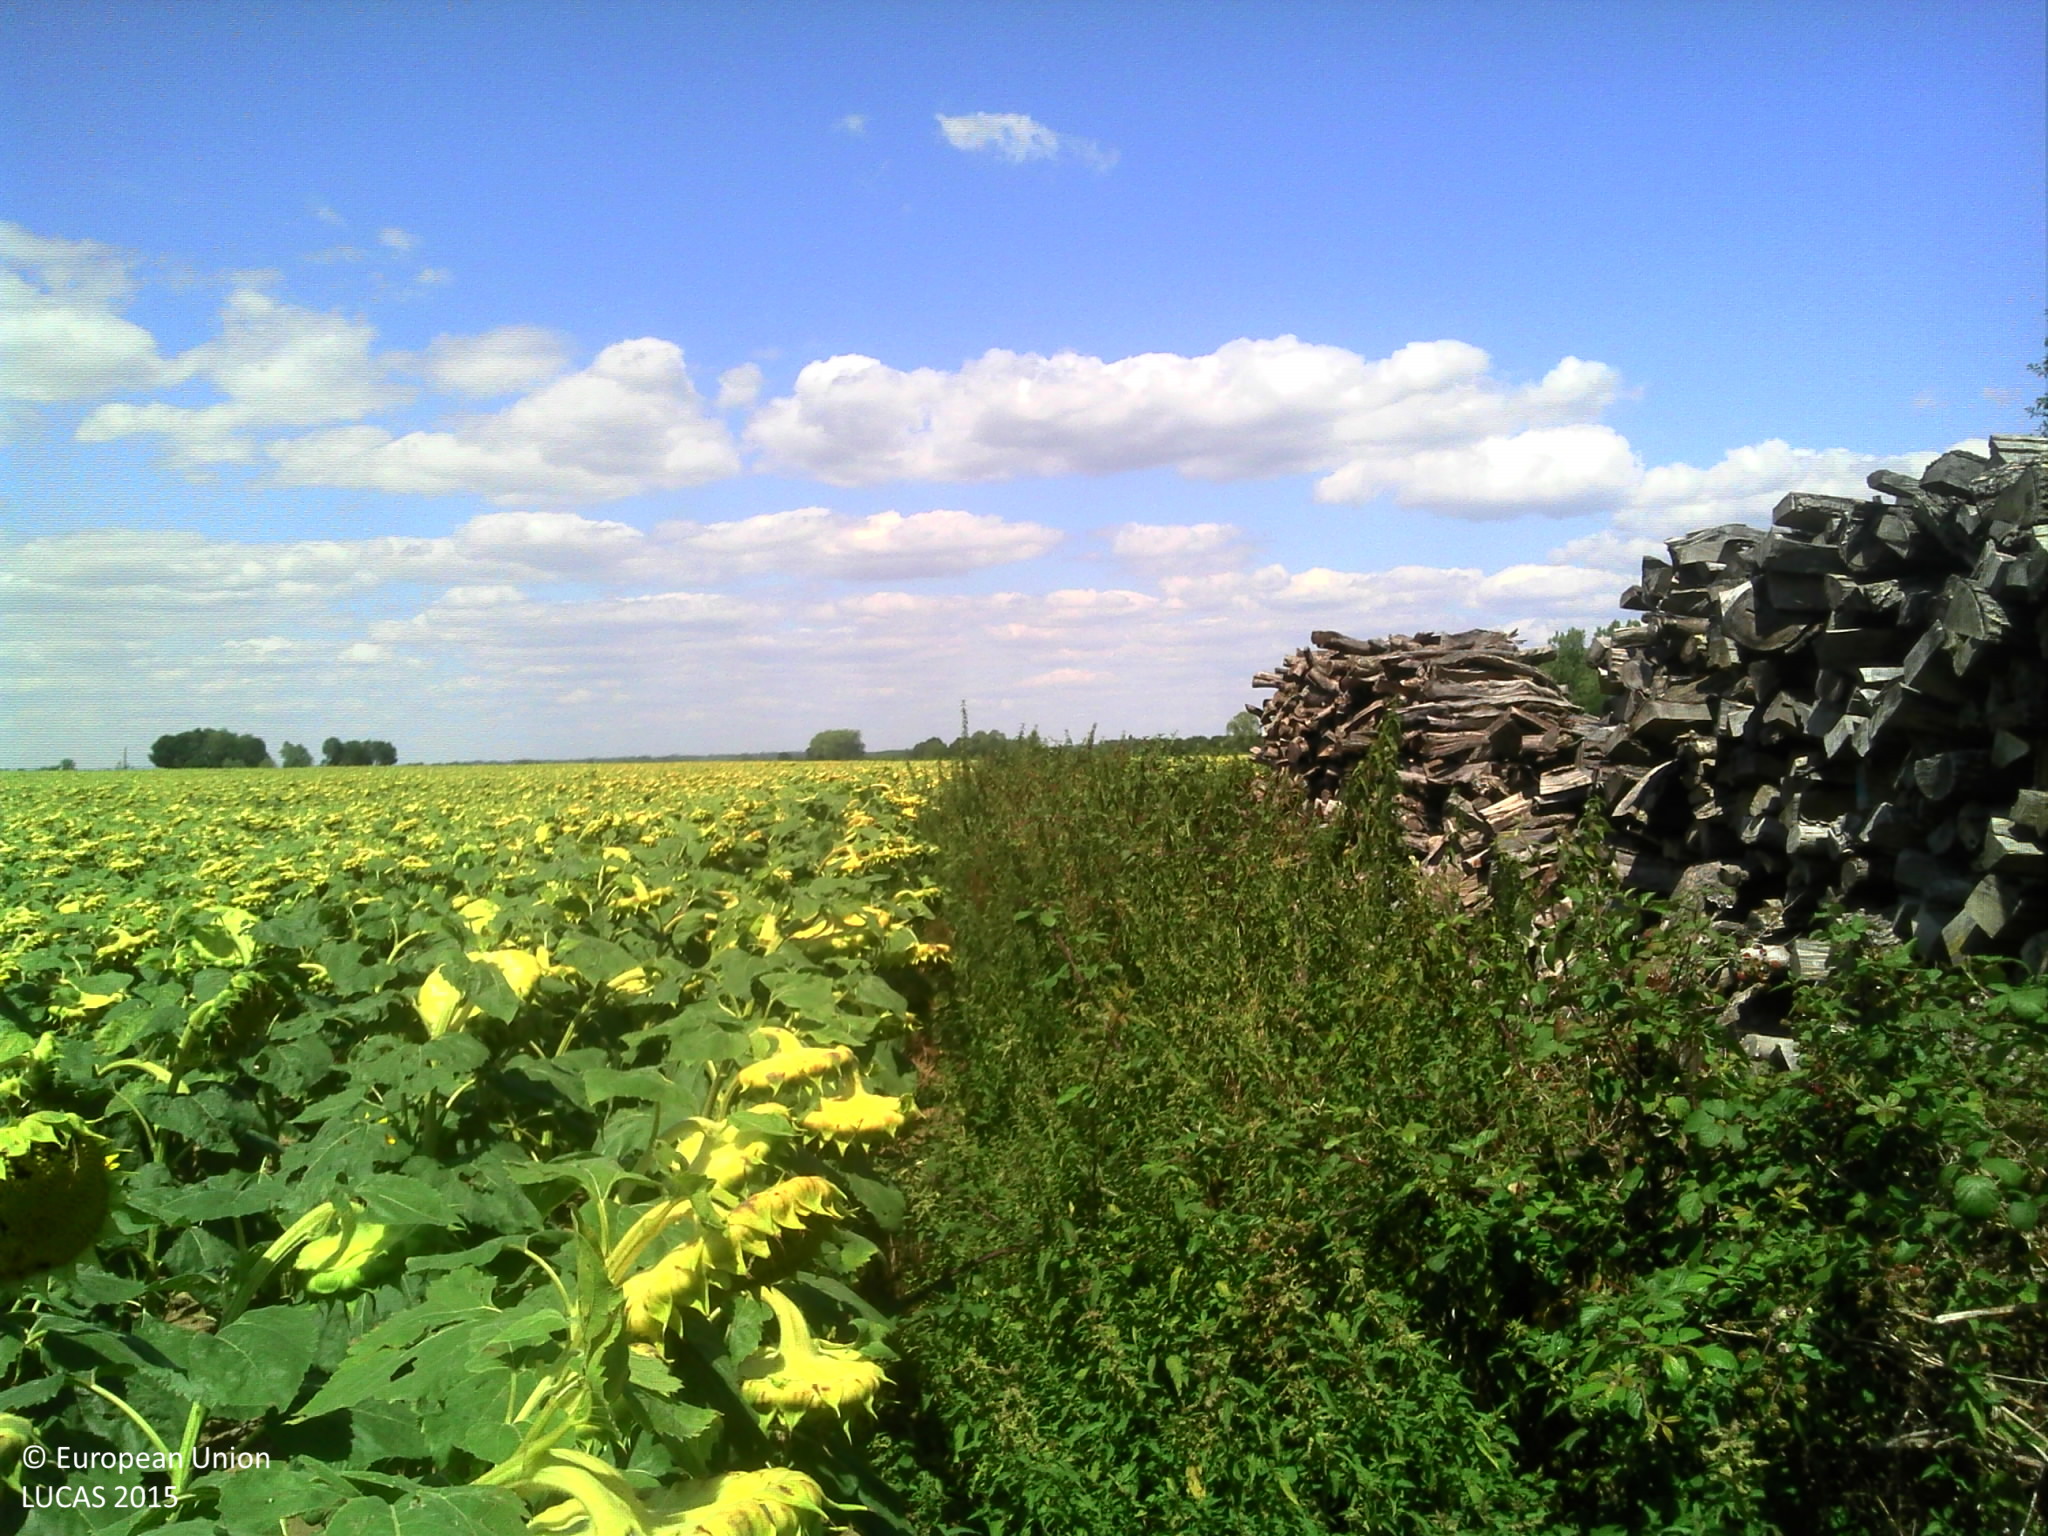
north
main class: Cropland
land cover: Sunflower
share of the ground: > 75 %
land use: Agriculture (excluding fallow land and kitchen gardens)
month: July
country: FR
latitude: 46.6647
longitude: 4.9437
